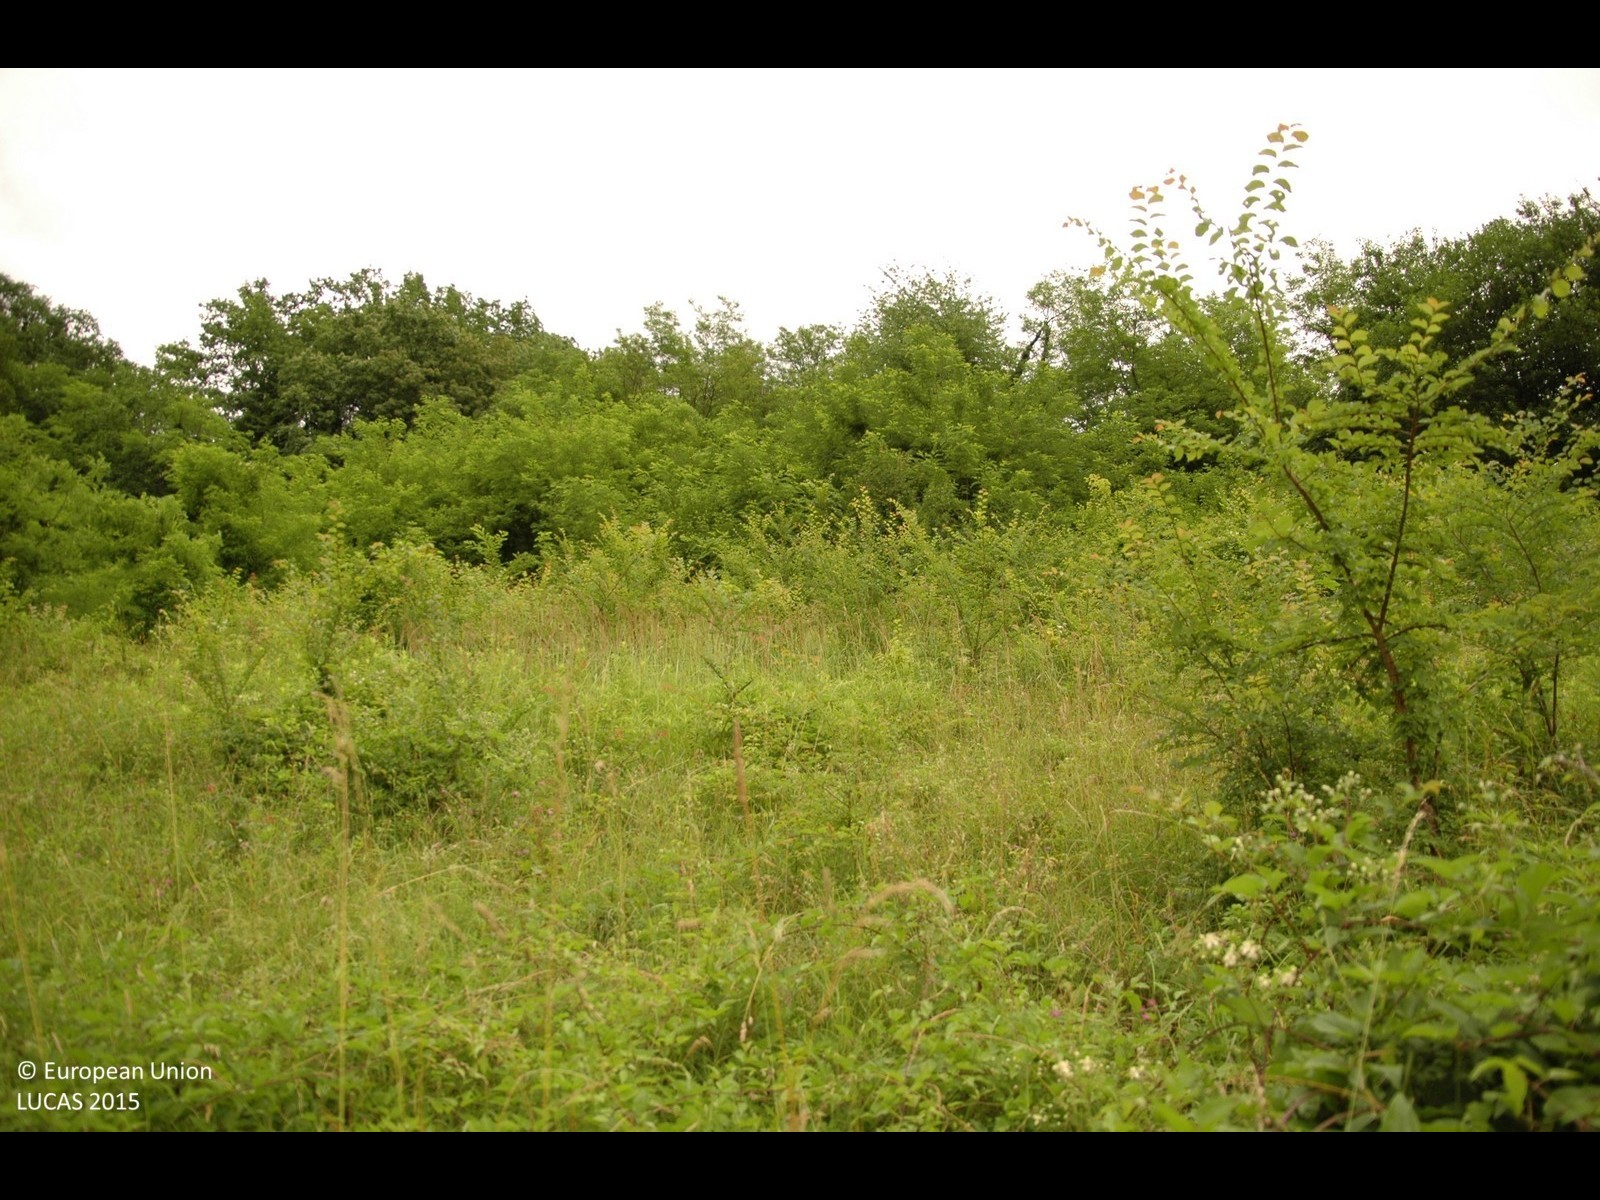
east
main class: Grassland
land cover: Spontaneously vegetated surfaces
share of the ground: > 75 %
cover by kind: herbaceous plants 95 %, shrubs 5 %
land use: Abandoned areas
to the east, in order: Spontaneously vegetated surfaces; Broadleaved woodland; Grassland without tree/shrub cover; Vineyards
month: June
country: HR
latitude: 46.0989
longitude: 15.8841
